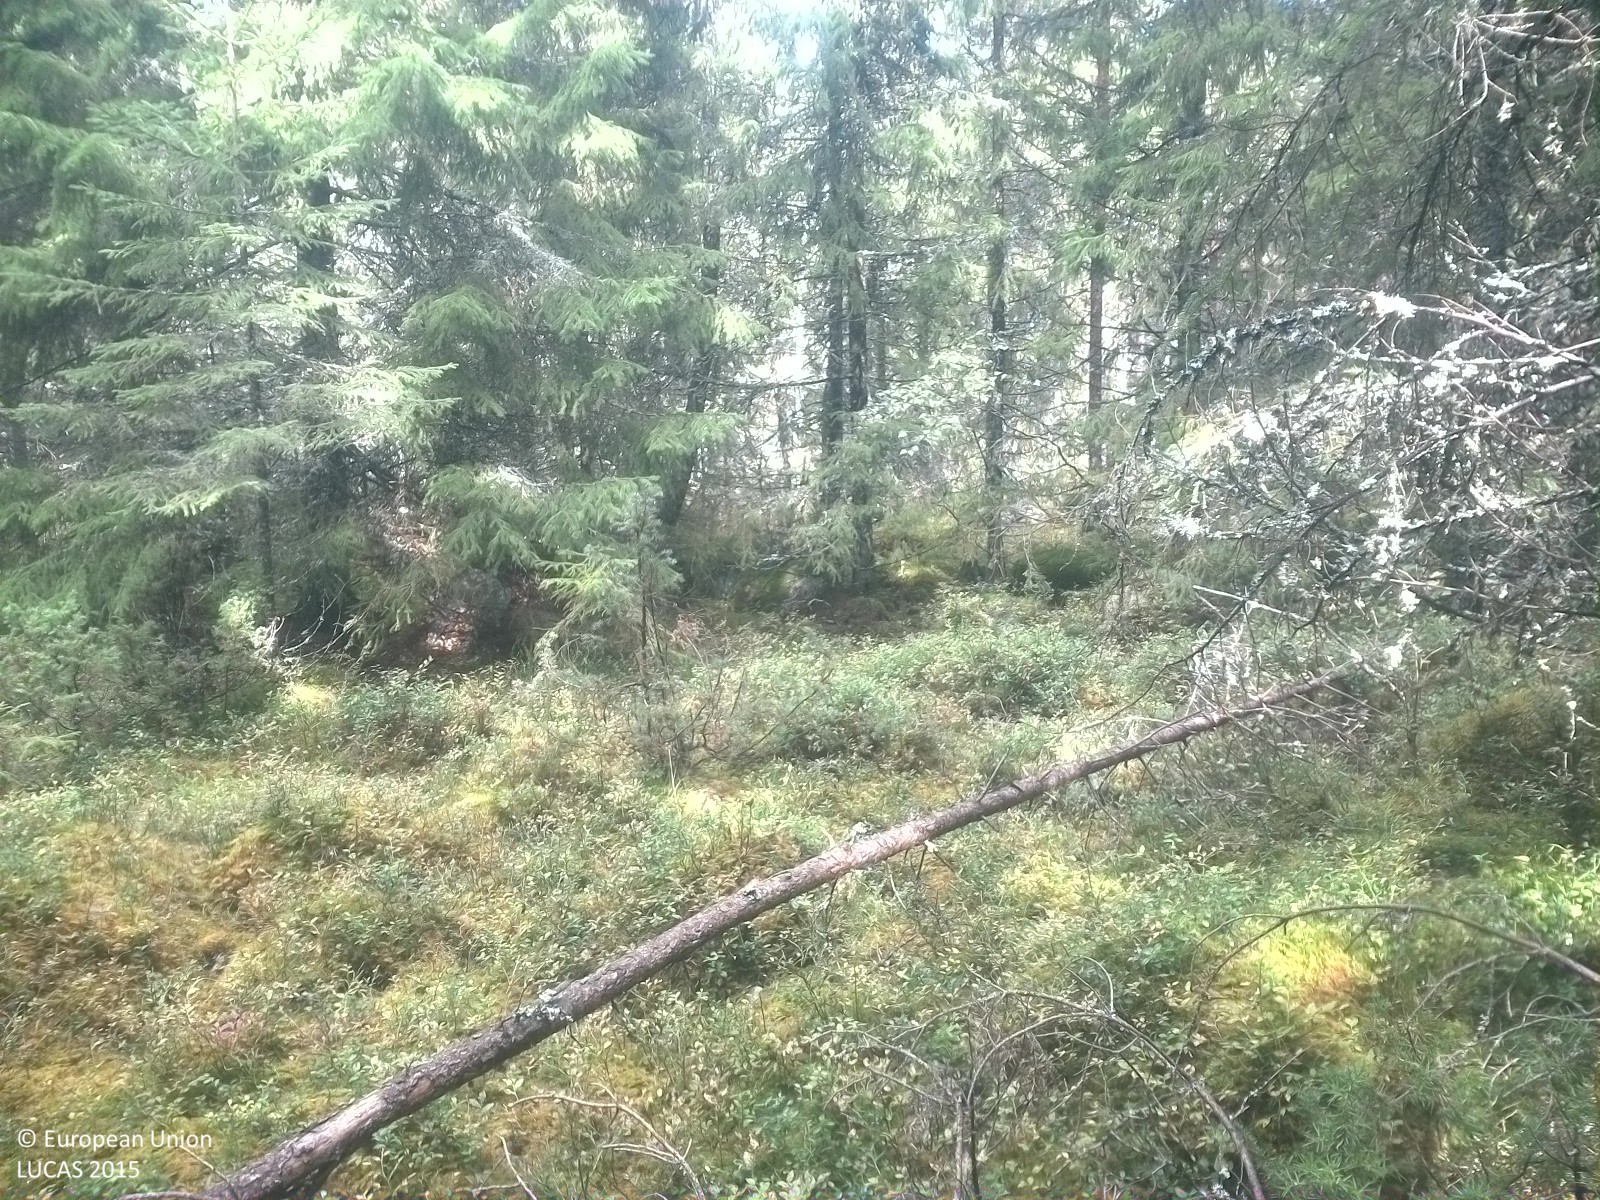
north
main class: Woodland
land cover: Spruce dominated coniferous woodland
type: boreal forest
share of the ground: 25 - 50 %
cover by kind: coniferous forest trees 40 %, herbaceous plants 25 %, lichens and mosses 25 %, broadleaved forest trees 5 %, shrubs 5 %
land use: Forestry
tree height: > 5 m
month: September
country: SE
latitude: 59.3985
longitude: 15.6801
